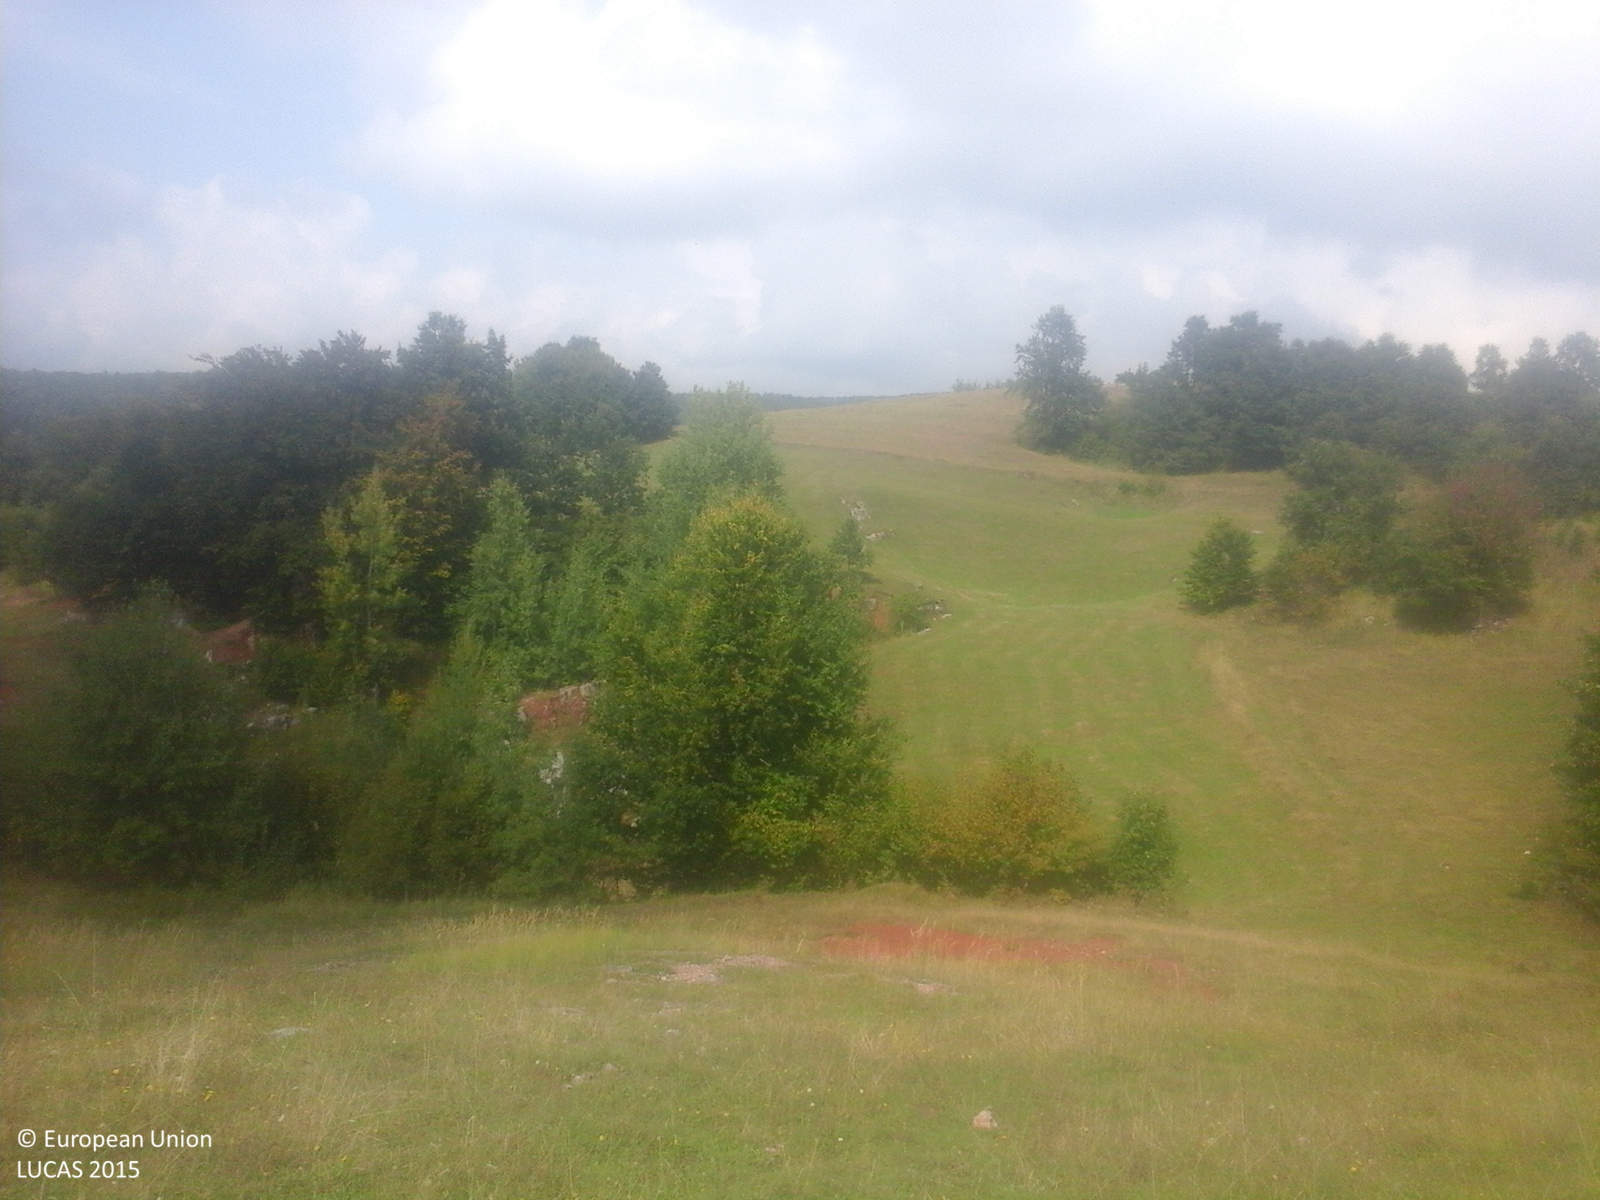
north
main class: Grassland
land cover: Grassland without tree/shrub cover
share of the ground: > 75 %
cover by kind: herbaceous plants 100 %
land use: Agriculture (excluding fallow land and kitchen gardens)
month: September
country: RO
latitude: 46.8476
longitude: 22.3921
